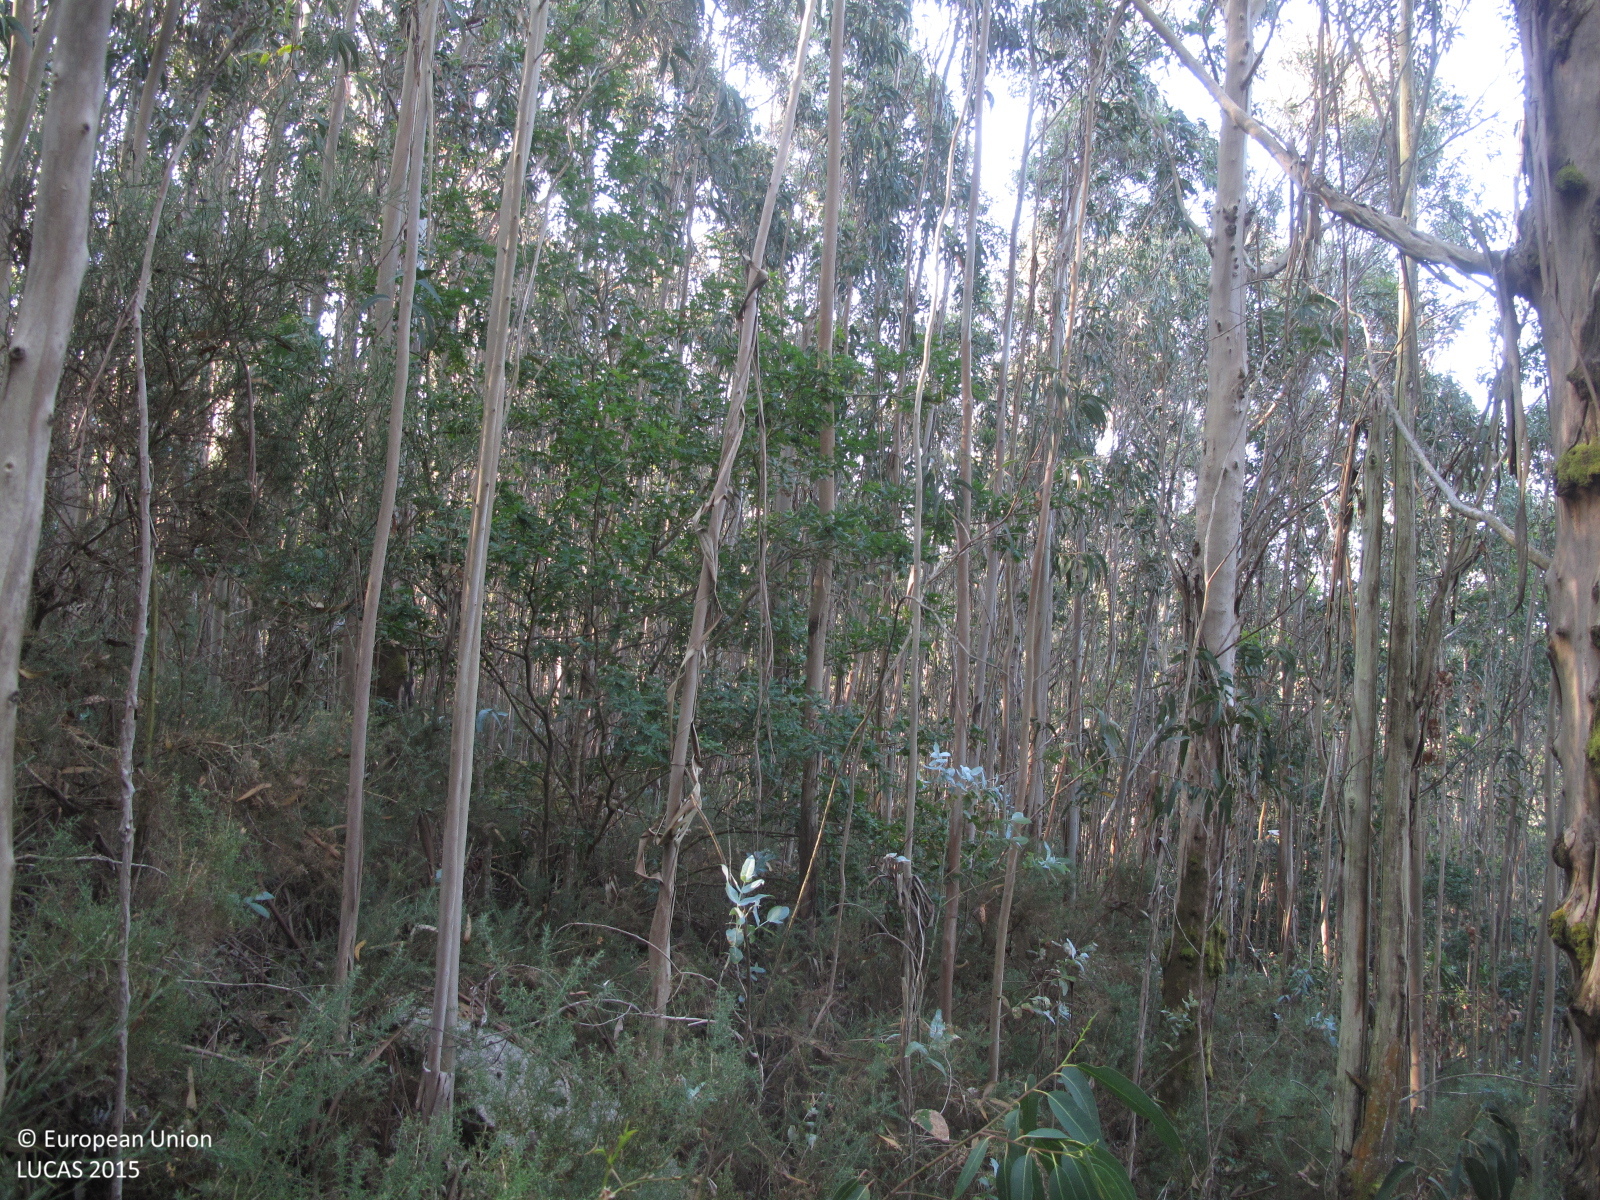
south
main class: Woodland
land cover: Broadleaved woodland
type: exotic forest
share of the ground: > 75 %
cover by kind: broadleaved forest trees 80 %, shrubs 20 %
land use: Forestry
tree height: > 5 m
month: July
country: ES
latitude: 42.8385
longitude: -9.0729
